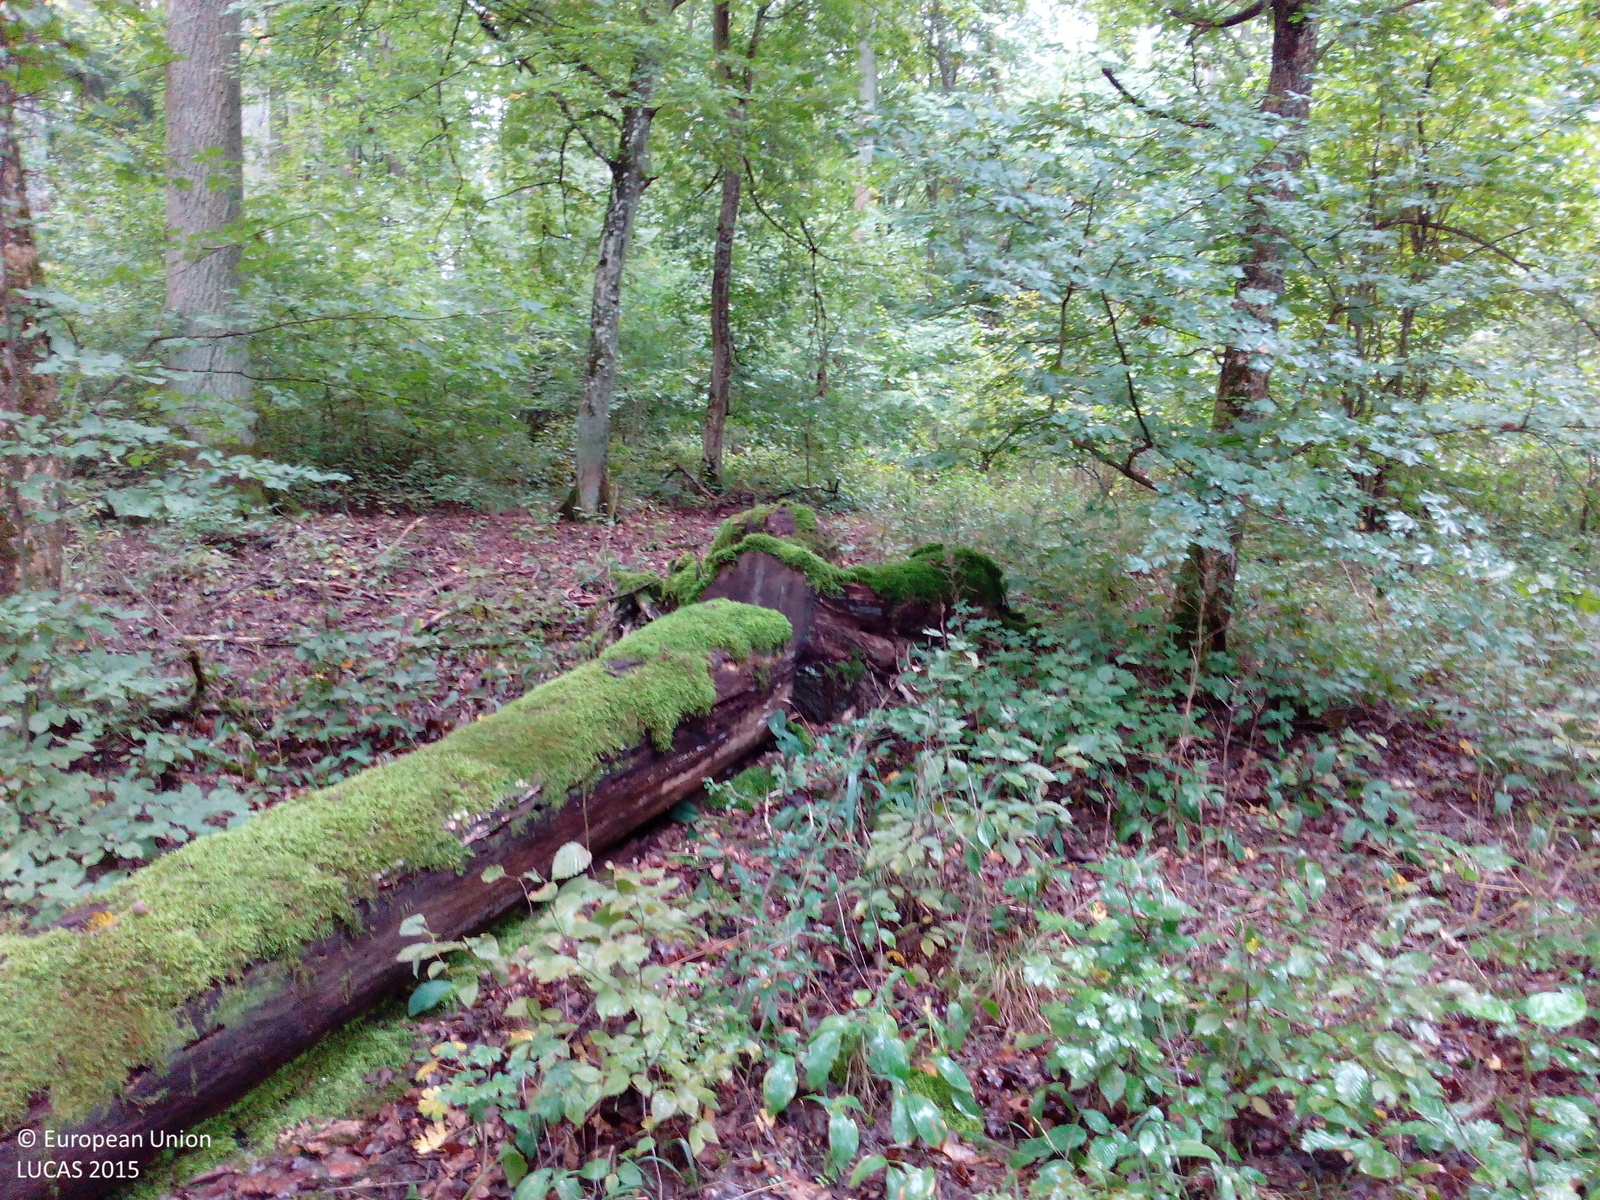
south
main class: Woodland
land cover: Broadleaved woodland
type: acidophilous oak and oak-birch forest
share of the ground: > 75 %
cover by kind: broadleaved forest trees 95 %, shrubs 5 %
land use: Forestry
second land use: Amenities, museums, leisure
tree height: > 5 m
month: September
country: DE
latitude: 49.9504
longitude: 9.9582
